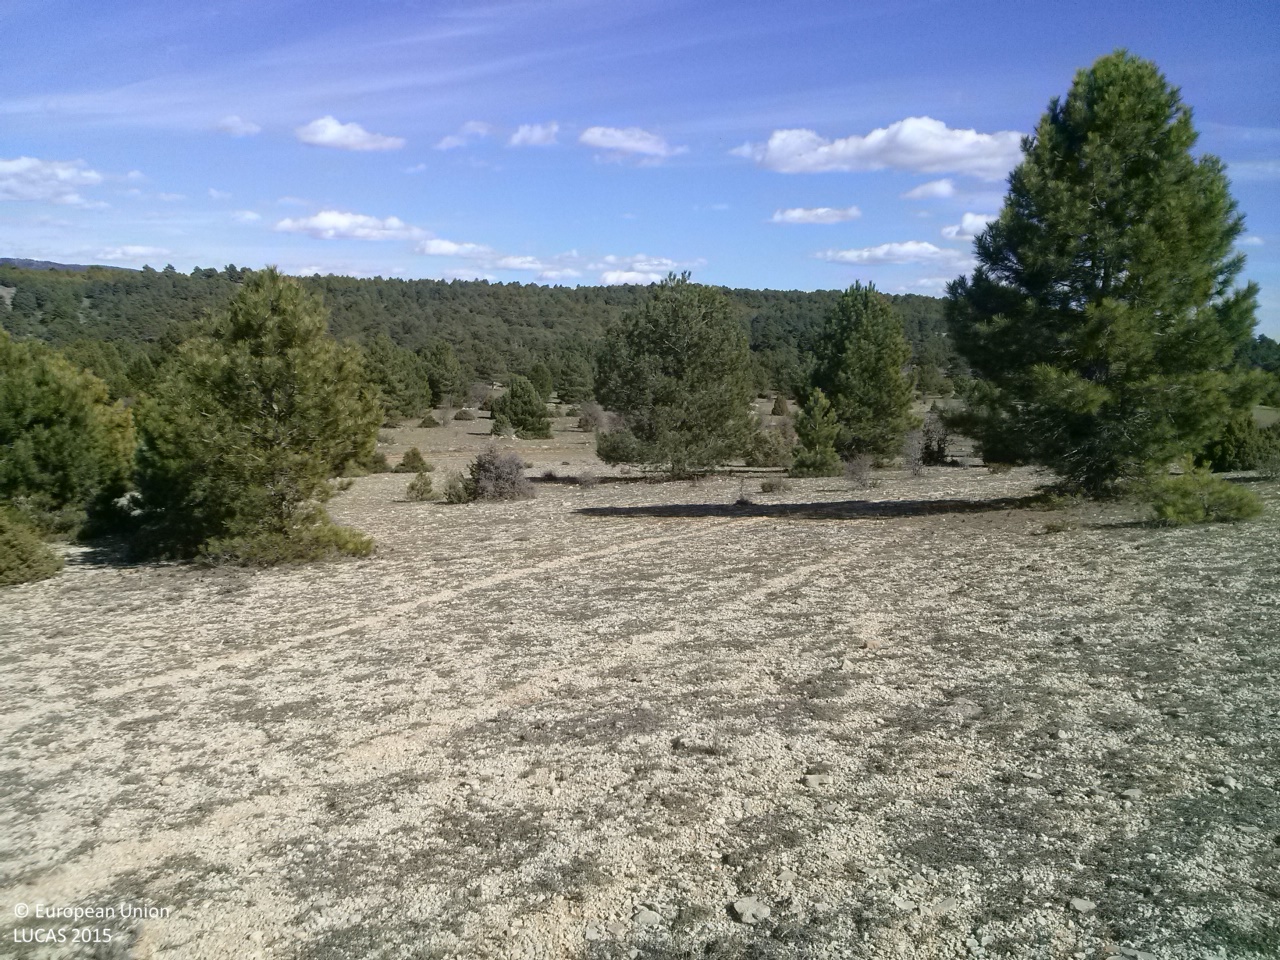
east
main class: Grassland
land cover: Grassland without tree/shrub cover
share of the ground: 25 - 50 %
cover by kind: unconsolidated bare surface 55 %, herbaceous plants 40 %, shrubs 5 %
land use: Agriculture (excluding fallow land and kitchen gardens)
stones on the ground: 25 - 50 %
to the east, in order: Grassland without tree/shrub cover; Grassland with sparse tree/shrub cover; Tracks; Grassland without tree/shrub cover; Grassland with sparse tree/shrub cover; Pine dominated coniferous woodland
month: April
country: ES
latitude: 40.1689
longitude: -1.8388
